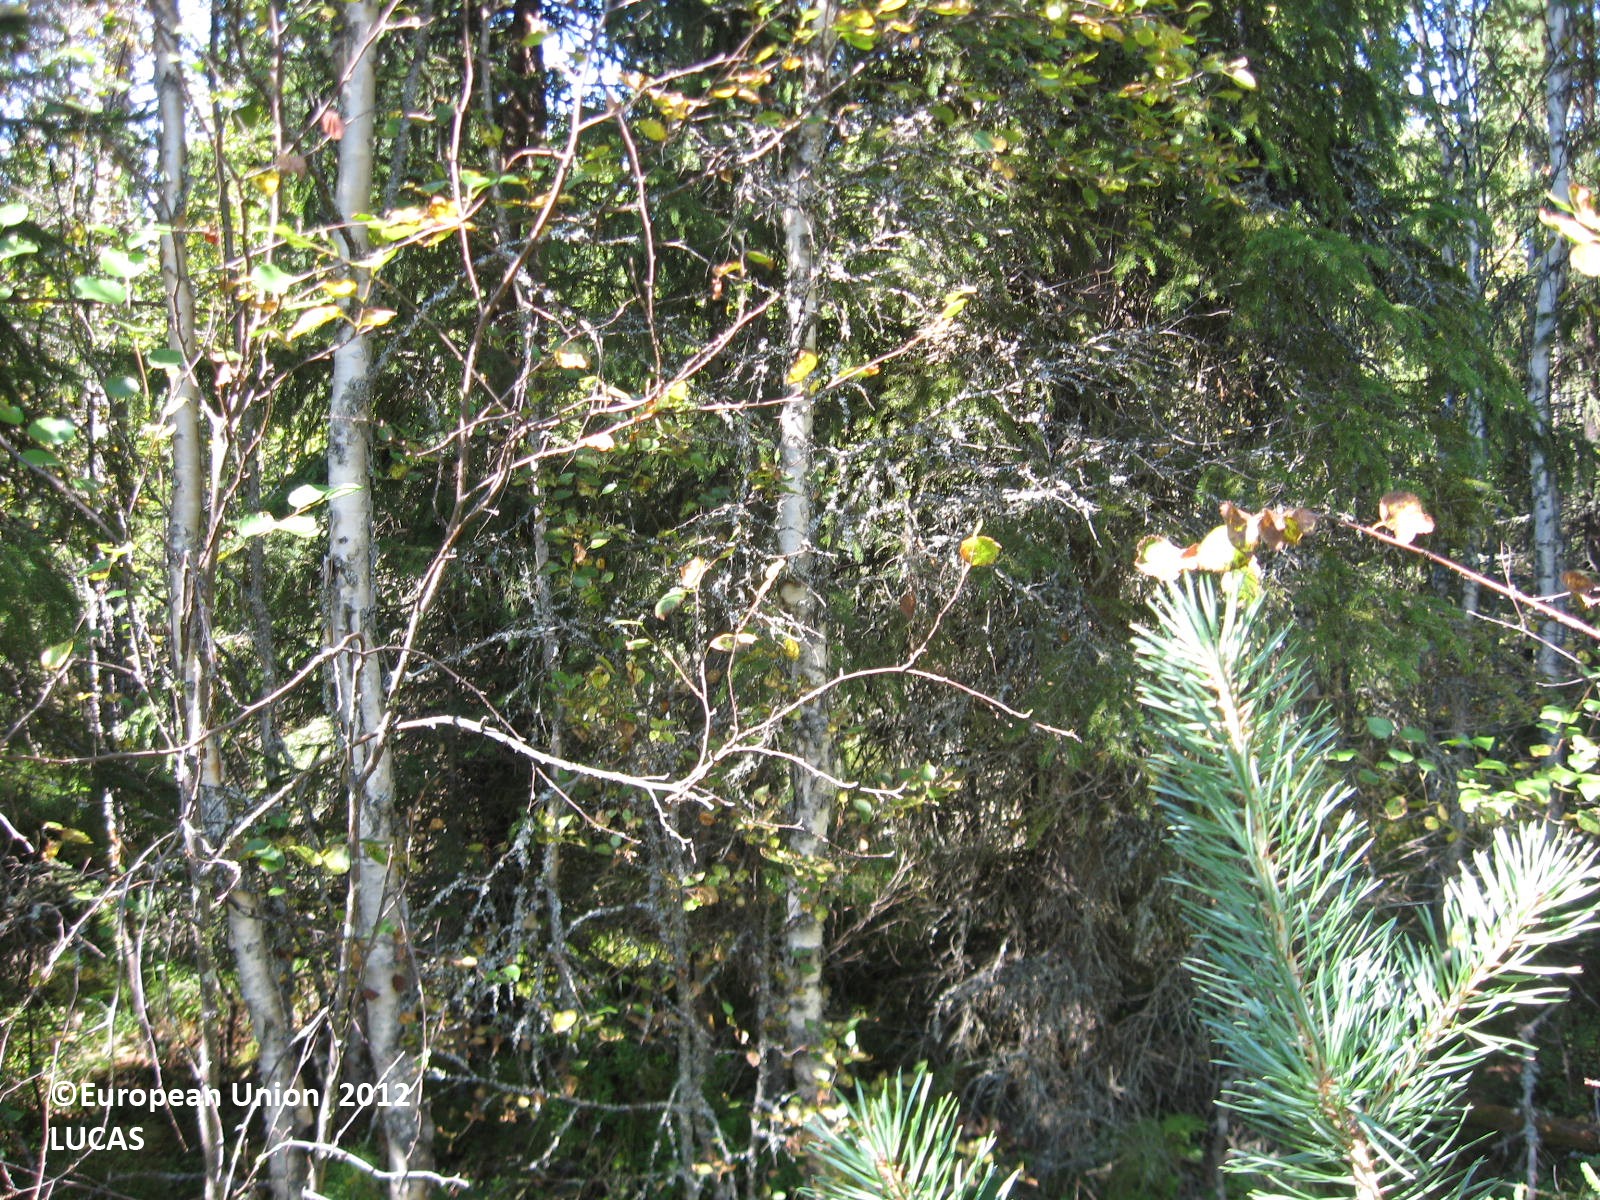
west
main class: Woodland
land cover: Other mixed woodland
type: boreal forest
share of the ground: > 75 %
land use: Forestry
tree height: > 5 m
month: August
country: FI
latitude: 63.8560
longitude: 28.6392
